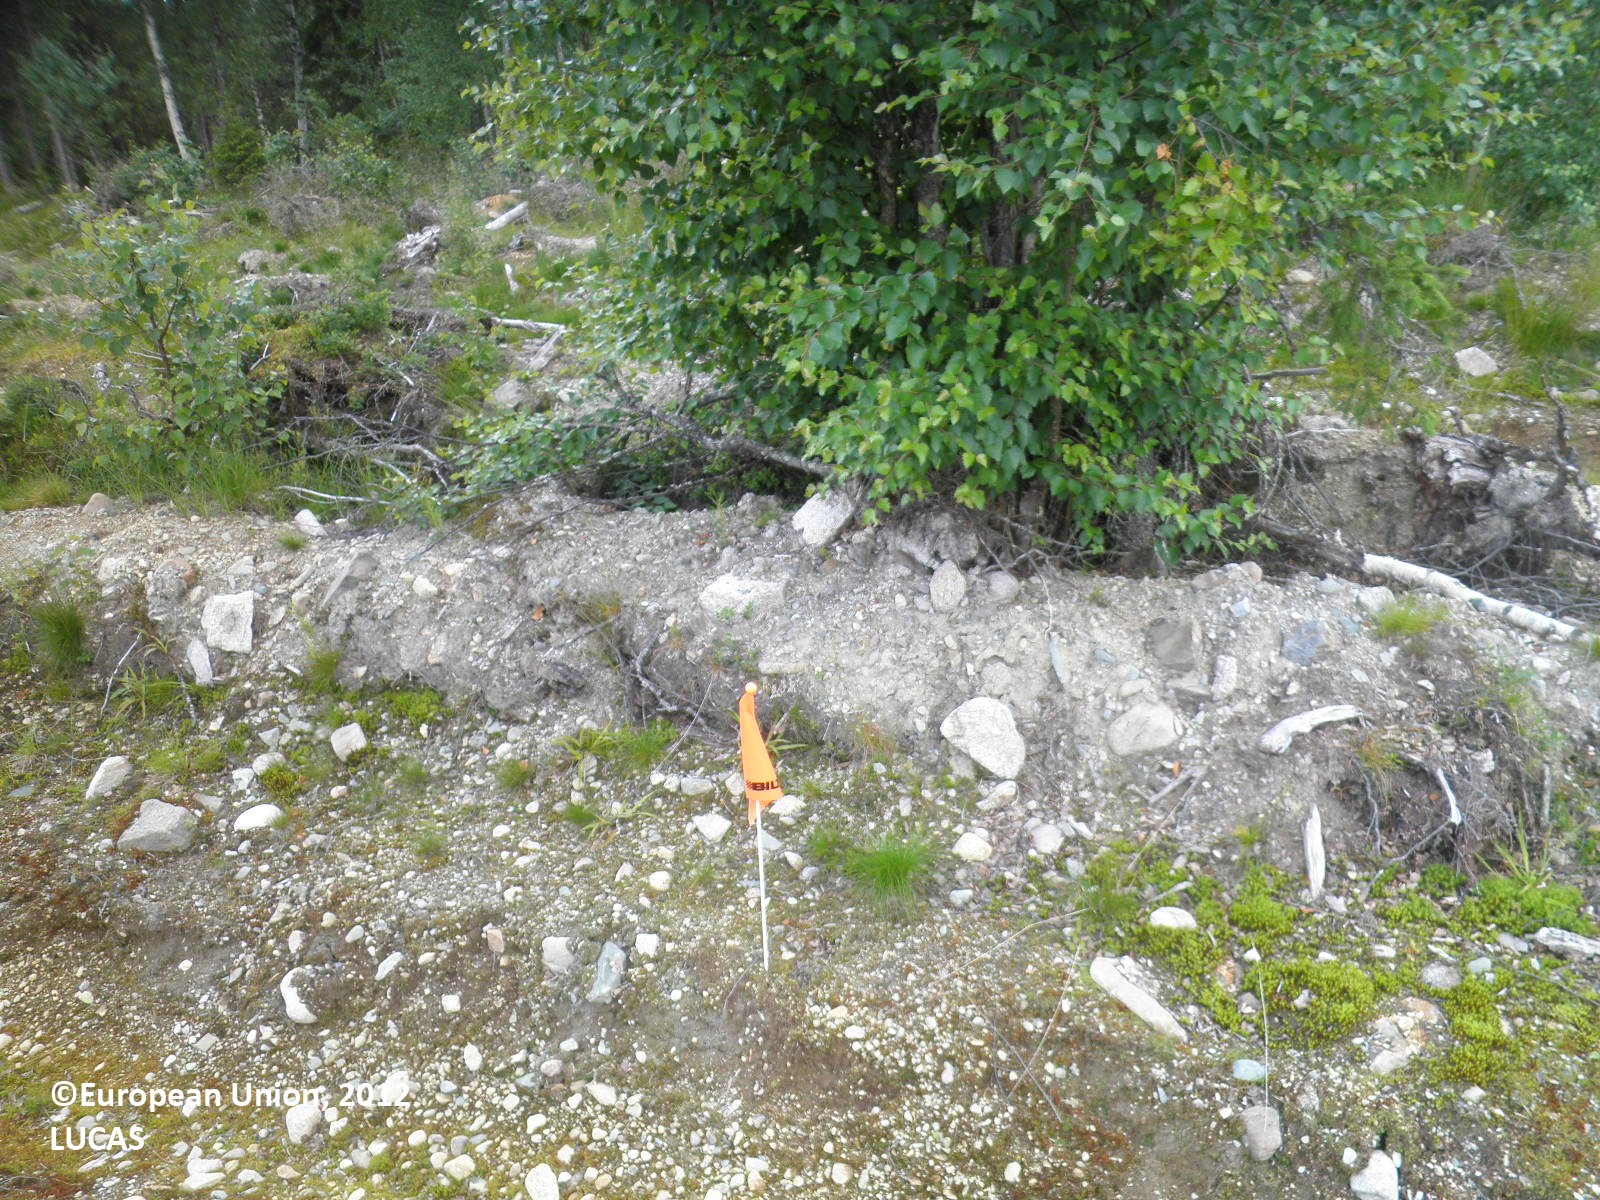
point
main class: Woodland
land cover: Broadleaved woodland
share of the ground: 10 - 25 %
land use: Forestry
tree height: > 5 m
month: July
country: FI
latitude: 67.6159
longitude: 26.0845
